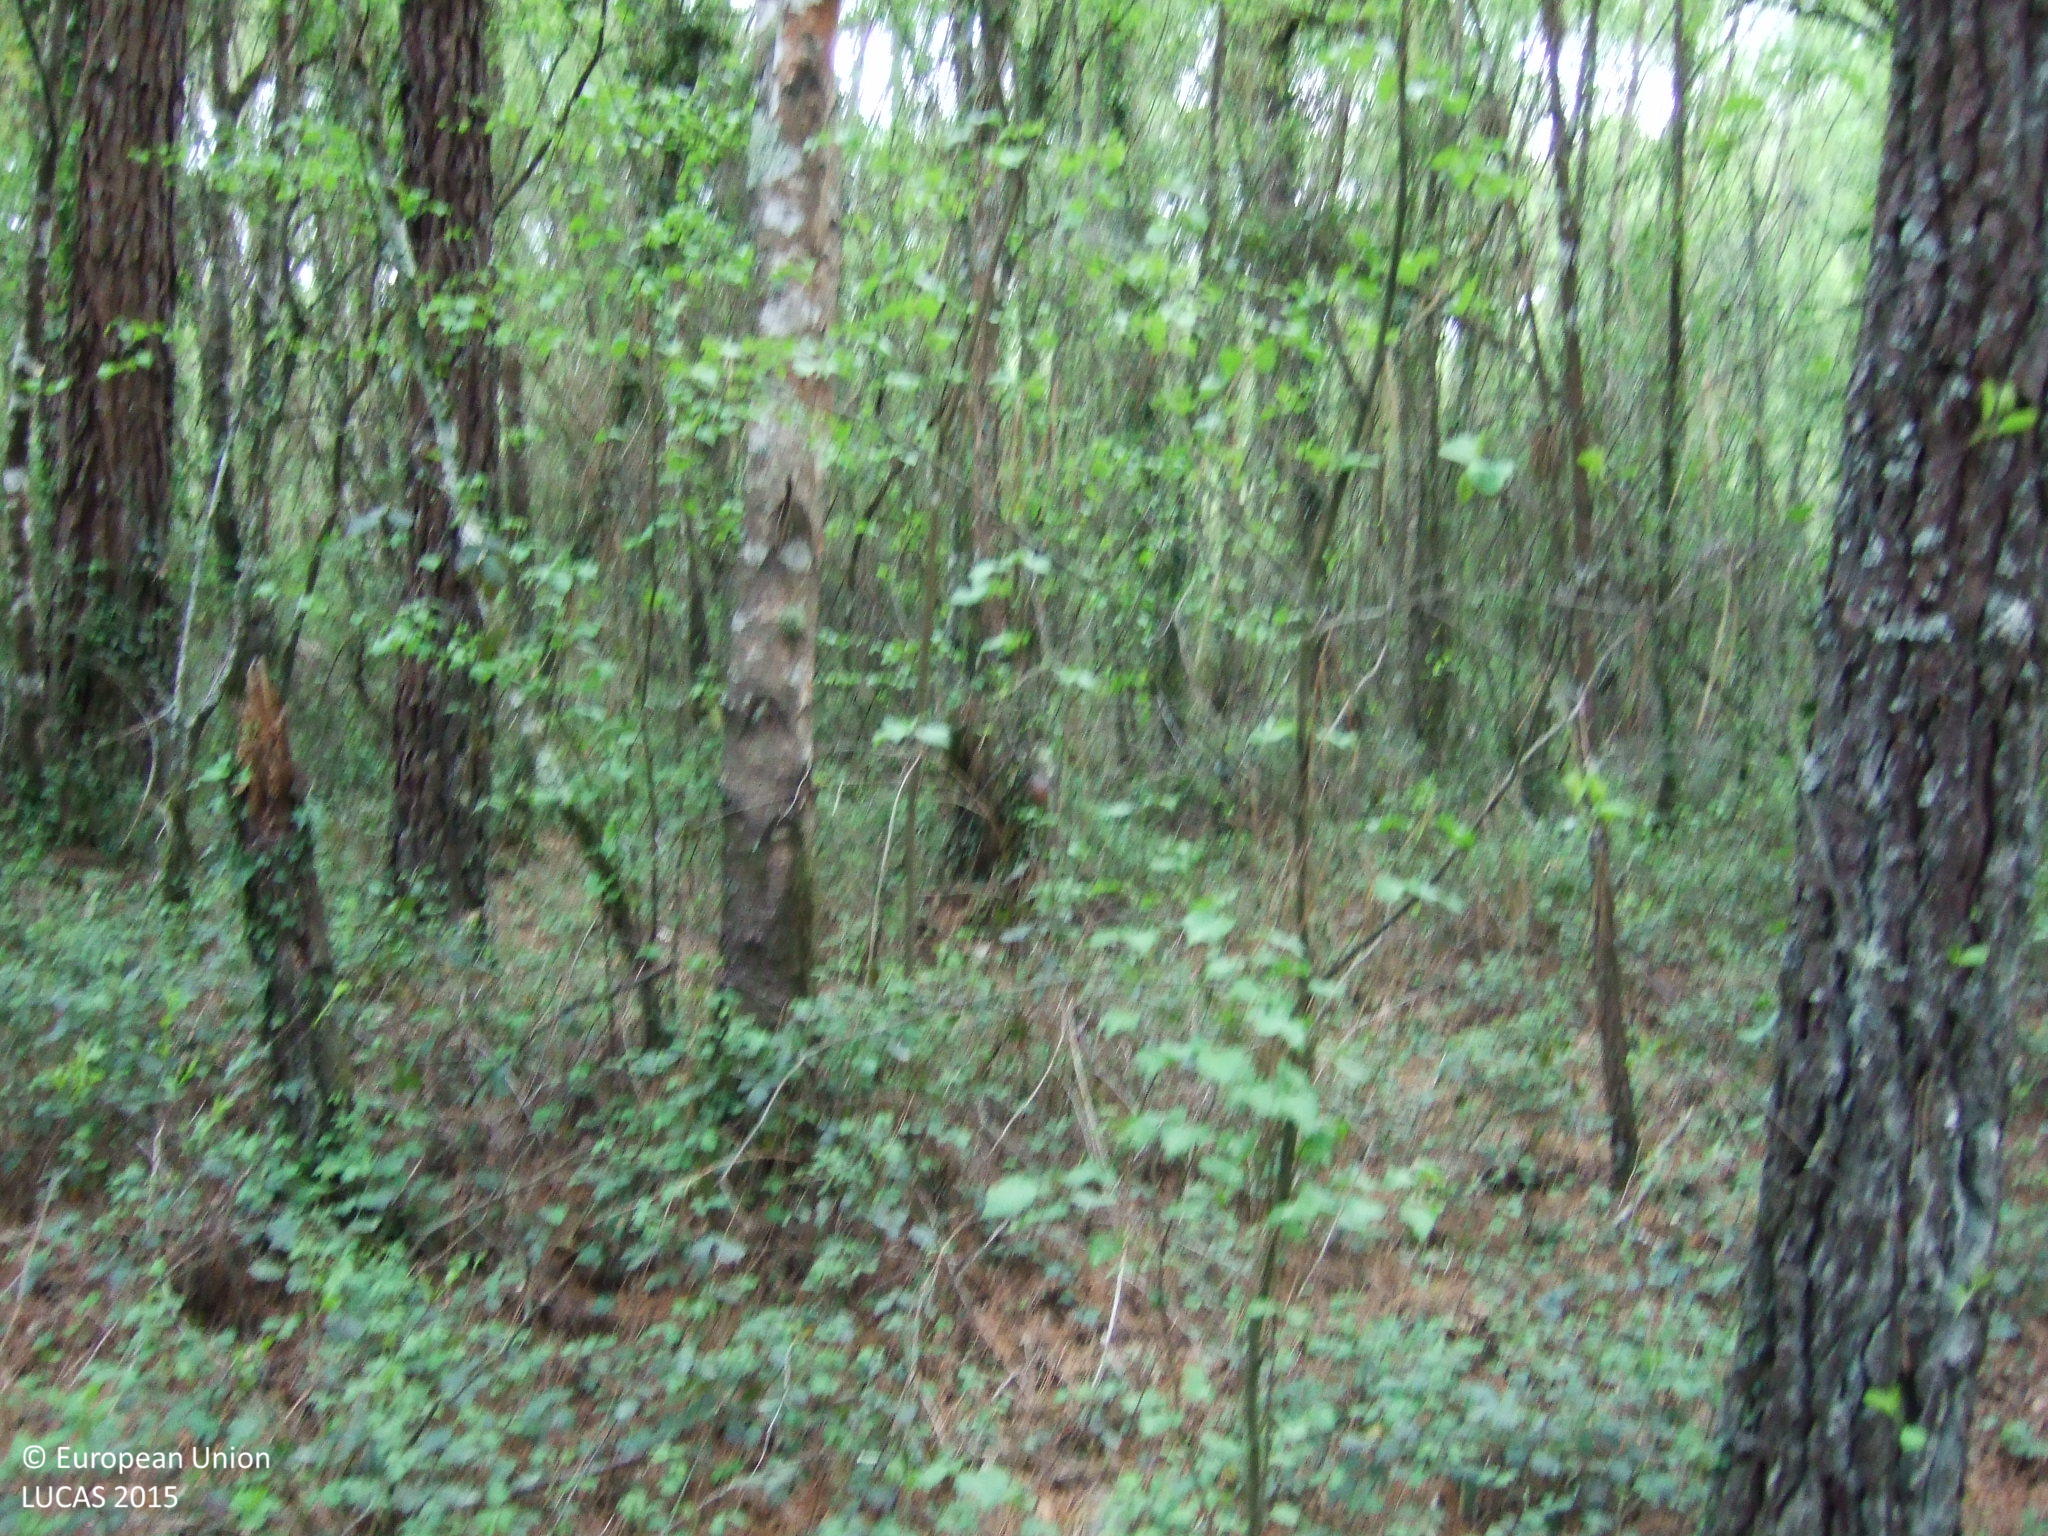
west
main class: Woodland
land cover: Other mixed woodland
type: acidophilous oak and oak-birch forest
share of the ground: > 75 %
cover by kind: broadleaved forest trees 50 %, coniferous forest trees 25 %, shrubs 25 %
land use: Forestry
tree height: > 5 m
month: April
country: ES
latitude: 43.1628
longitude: -7.7082
